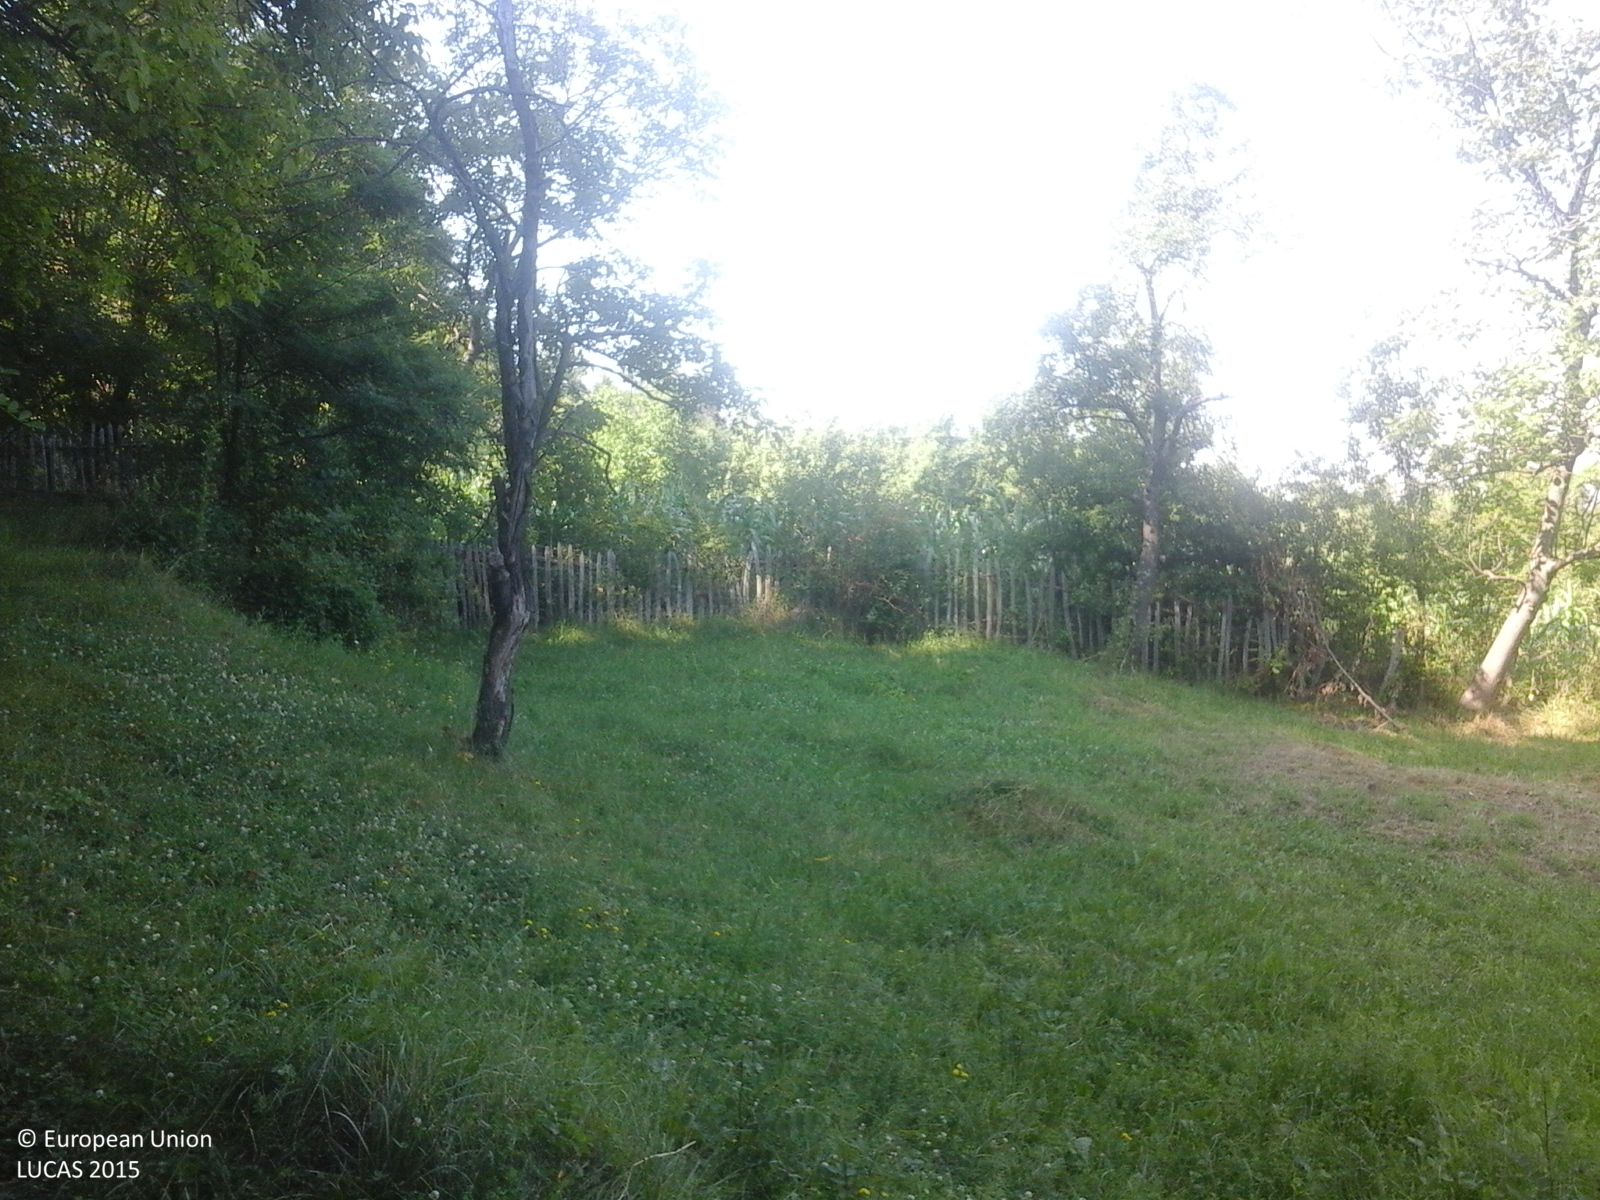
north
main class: Woodland
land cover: Broadleaved woodland
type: exotic forest
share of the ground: > 75 %
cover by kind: broadleaved forest trees 100 %
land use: Forestry
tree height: > 5 m
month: July
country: RO
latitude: 45.0371
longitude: 24.4313
